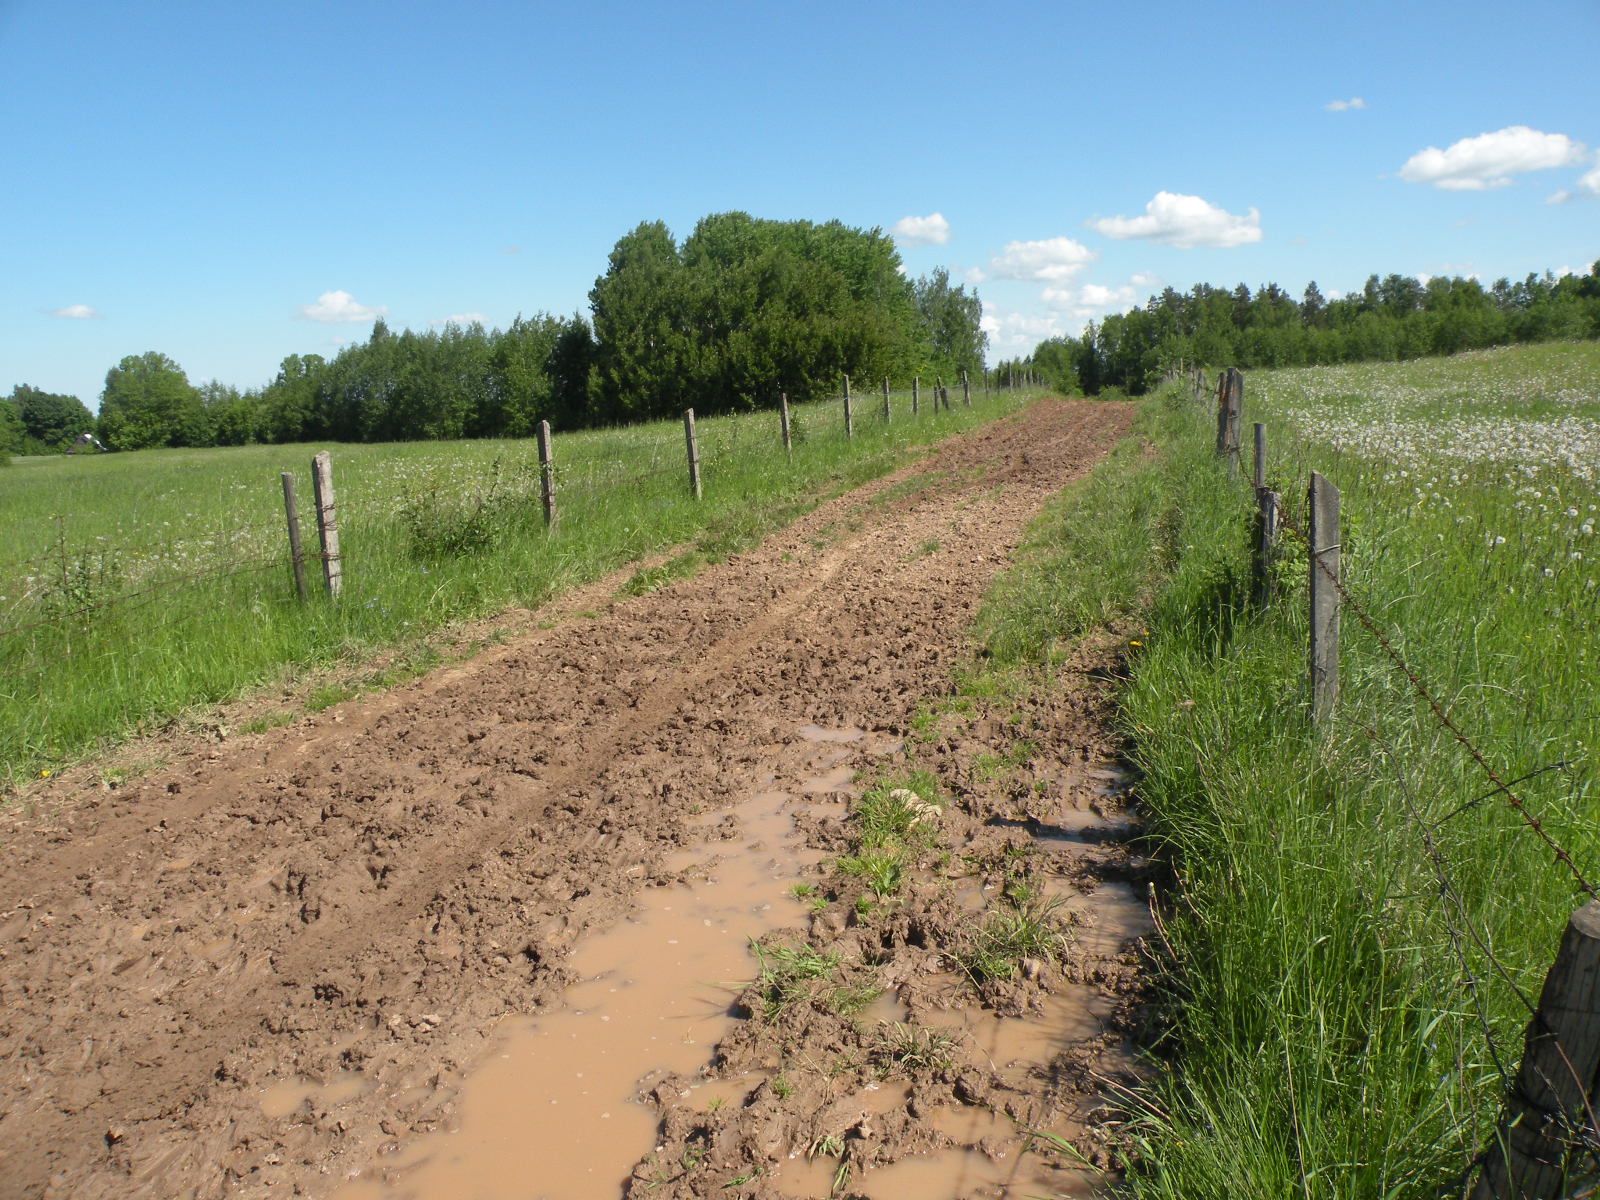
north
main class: Grassland
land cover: Grassland without tree/shrub cover
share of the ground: > 75 %
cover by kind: herbaceous plants 100 %
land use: Agriculture (excluding fallow land and kitchen gardens)
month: May
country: LV
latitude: 56.0474
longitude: 26.2120
